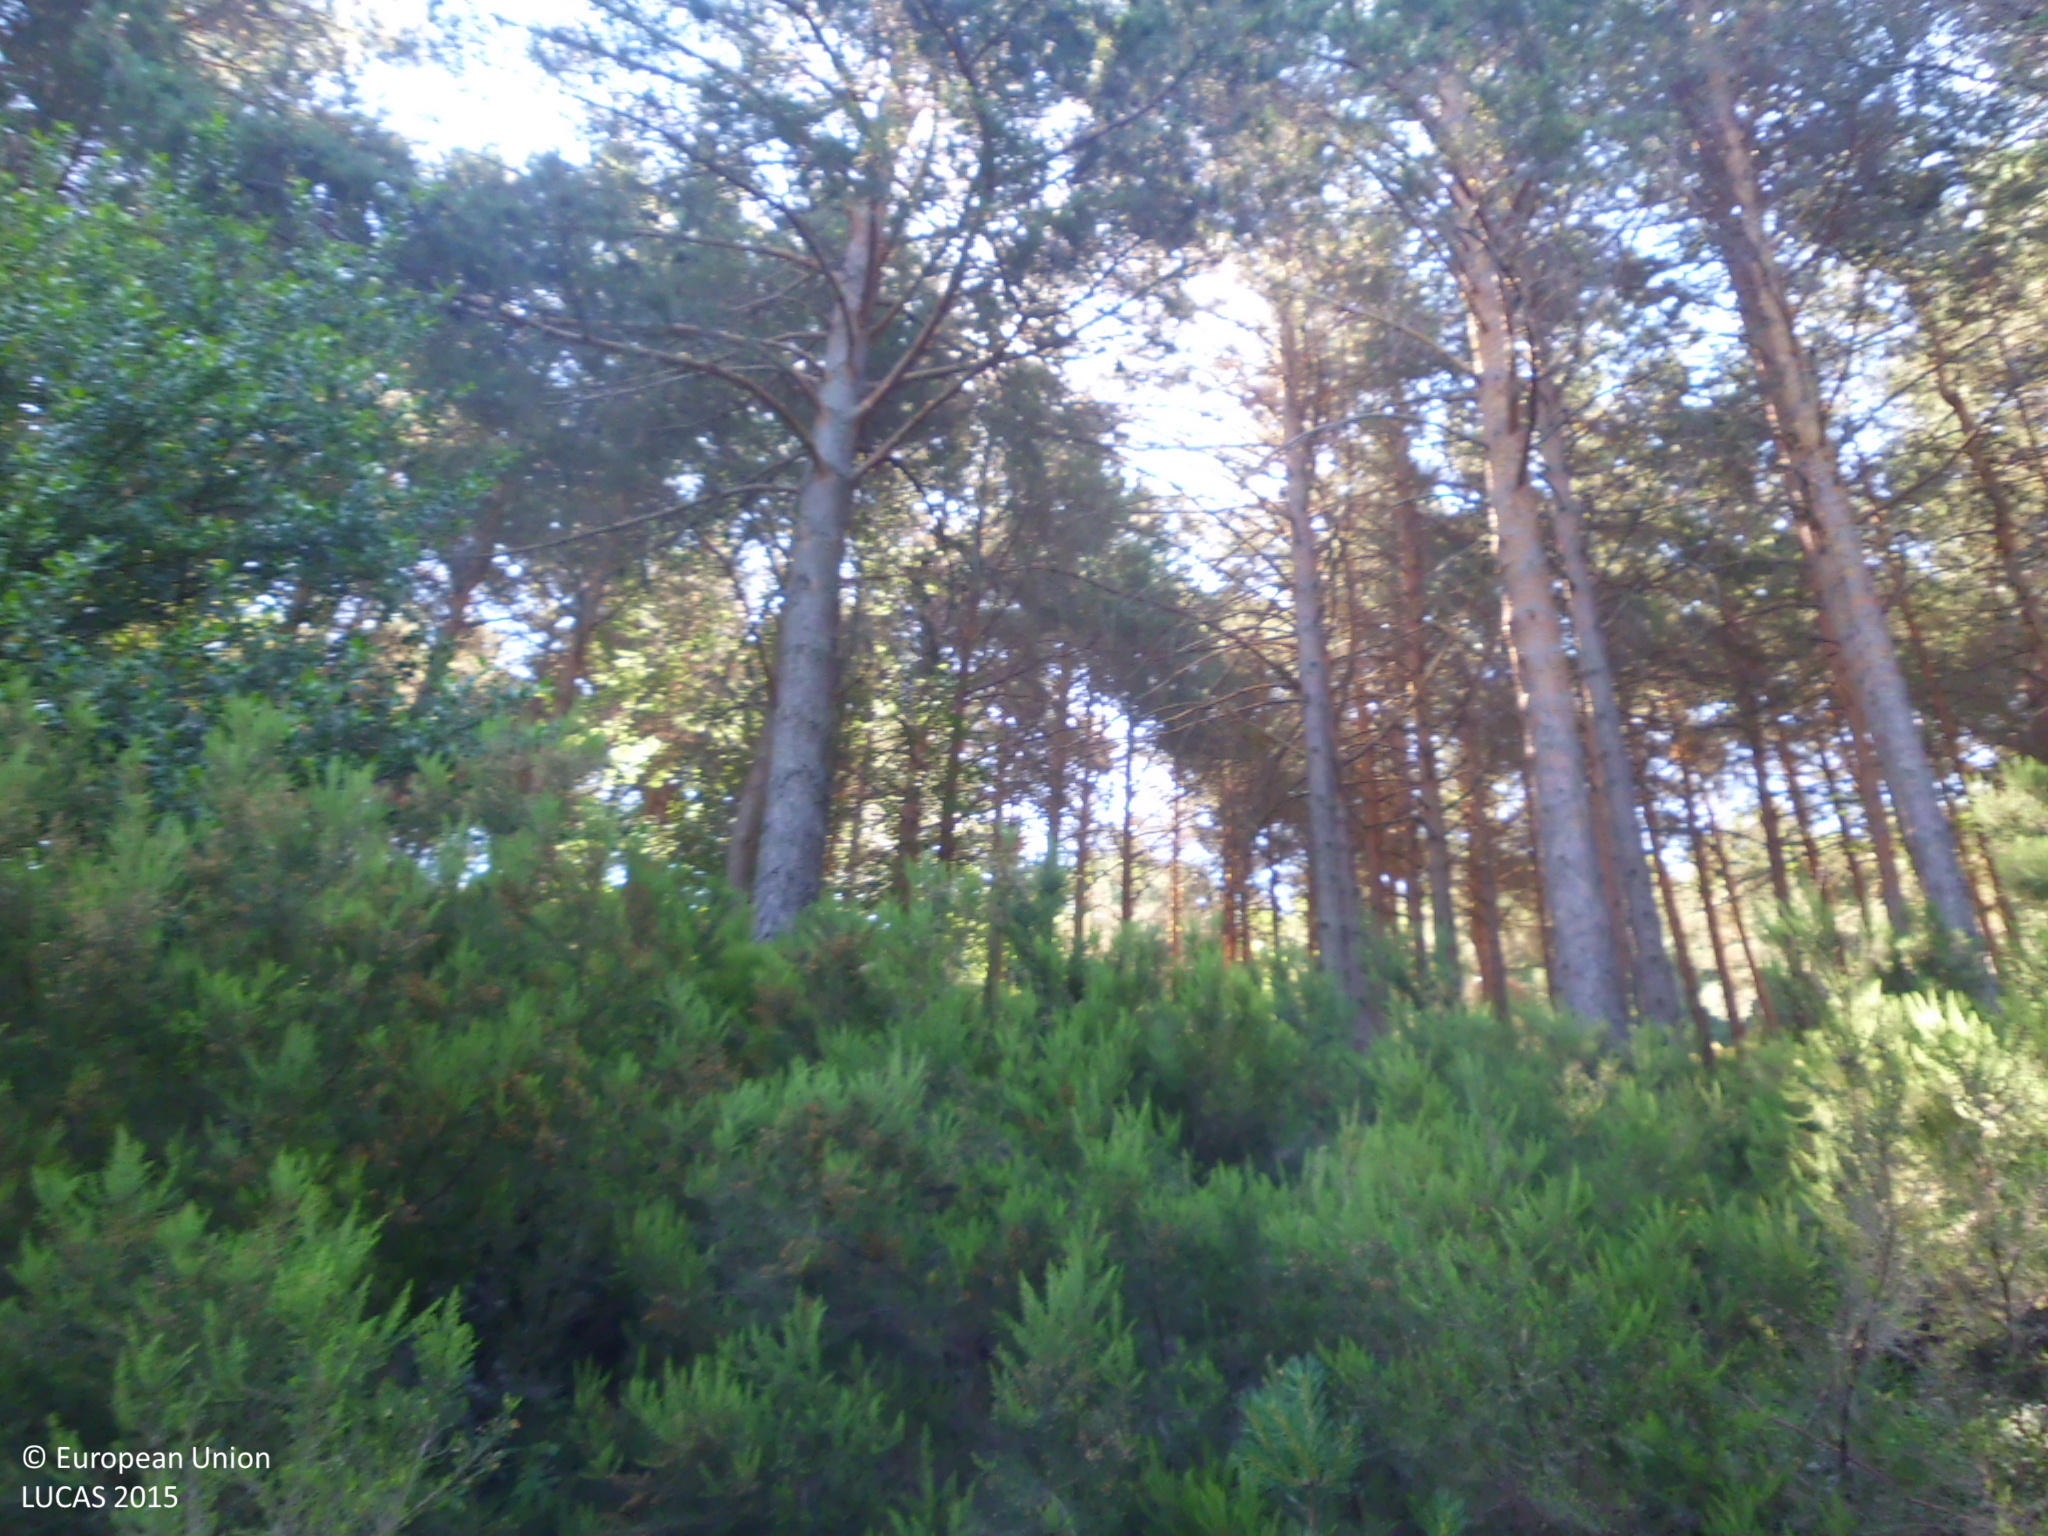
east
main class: Woodland
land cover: Pine dominated coniferous woodland
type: coniferous forest of the mediterranean region
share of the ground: > 75 %
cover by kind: coniferous forest trees 95 %, shrubs 5 %
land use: Forestry
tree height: > 5 m
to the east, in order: Pine dominated coniferous woodland
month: July
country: ES
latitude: 42.2204
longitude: -3.3684
